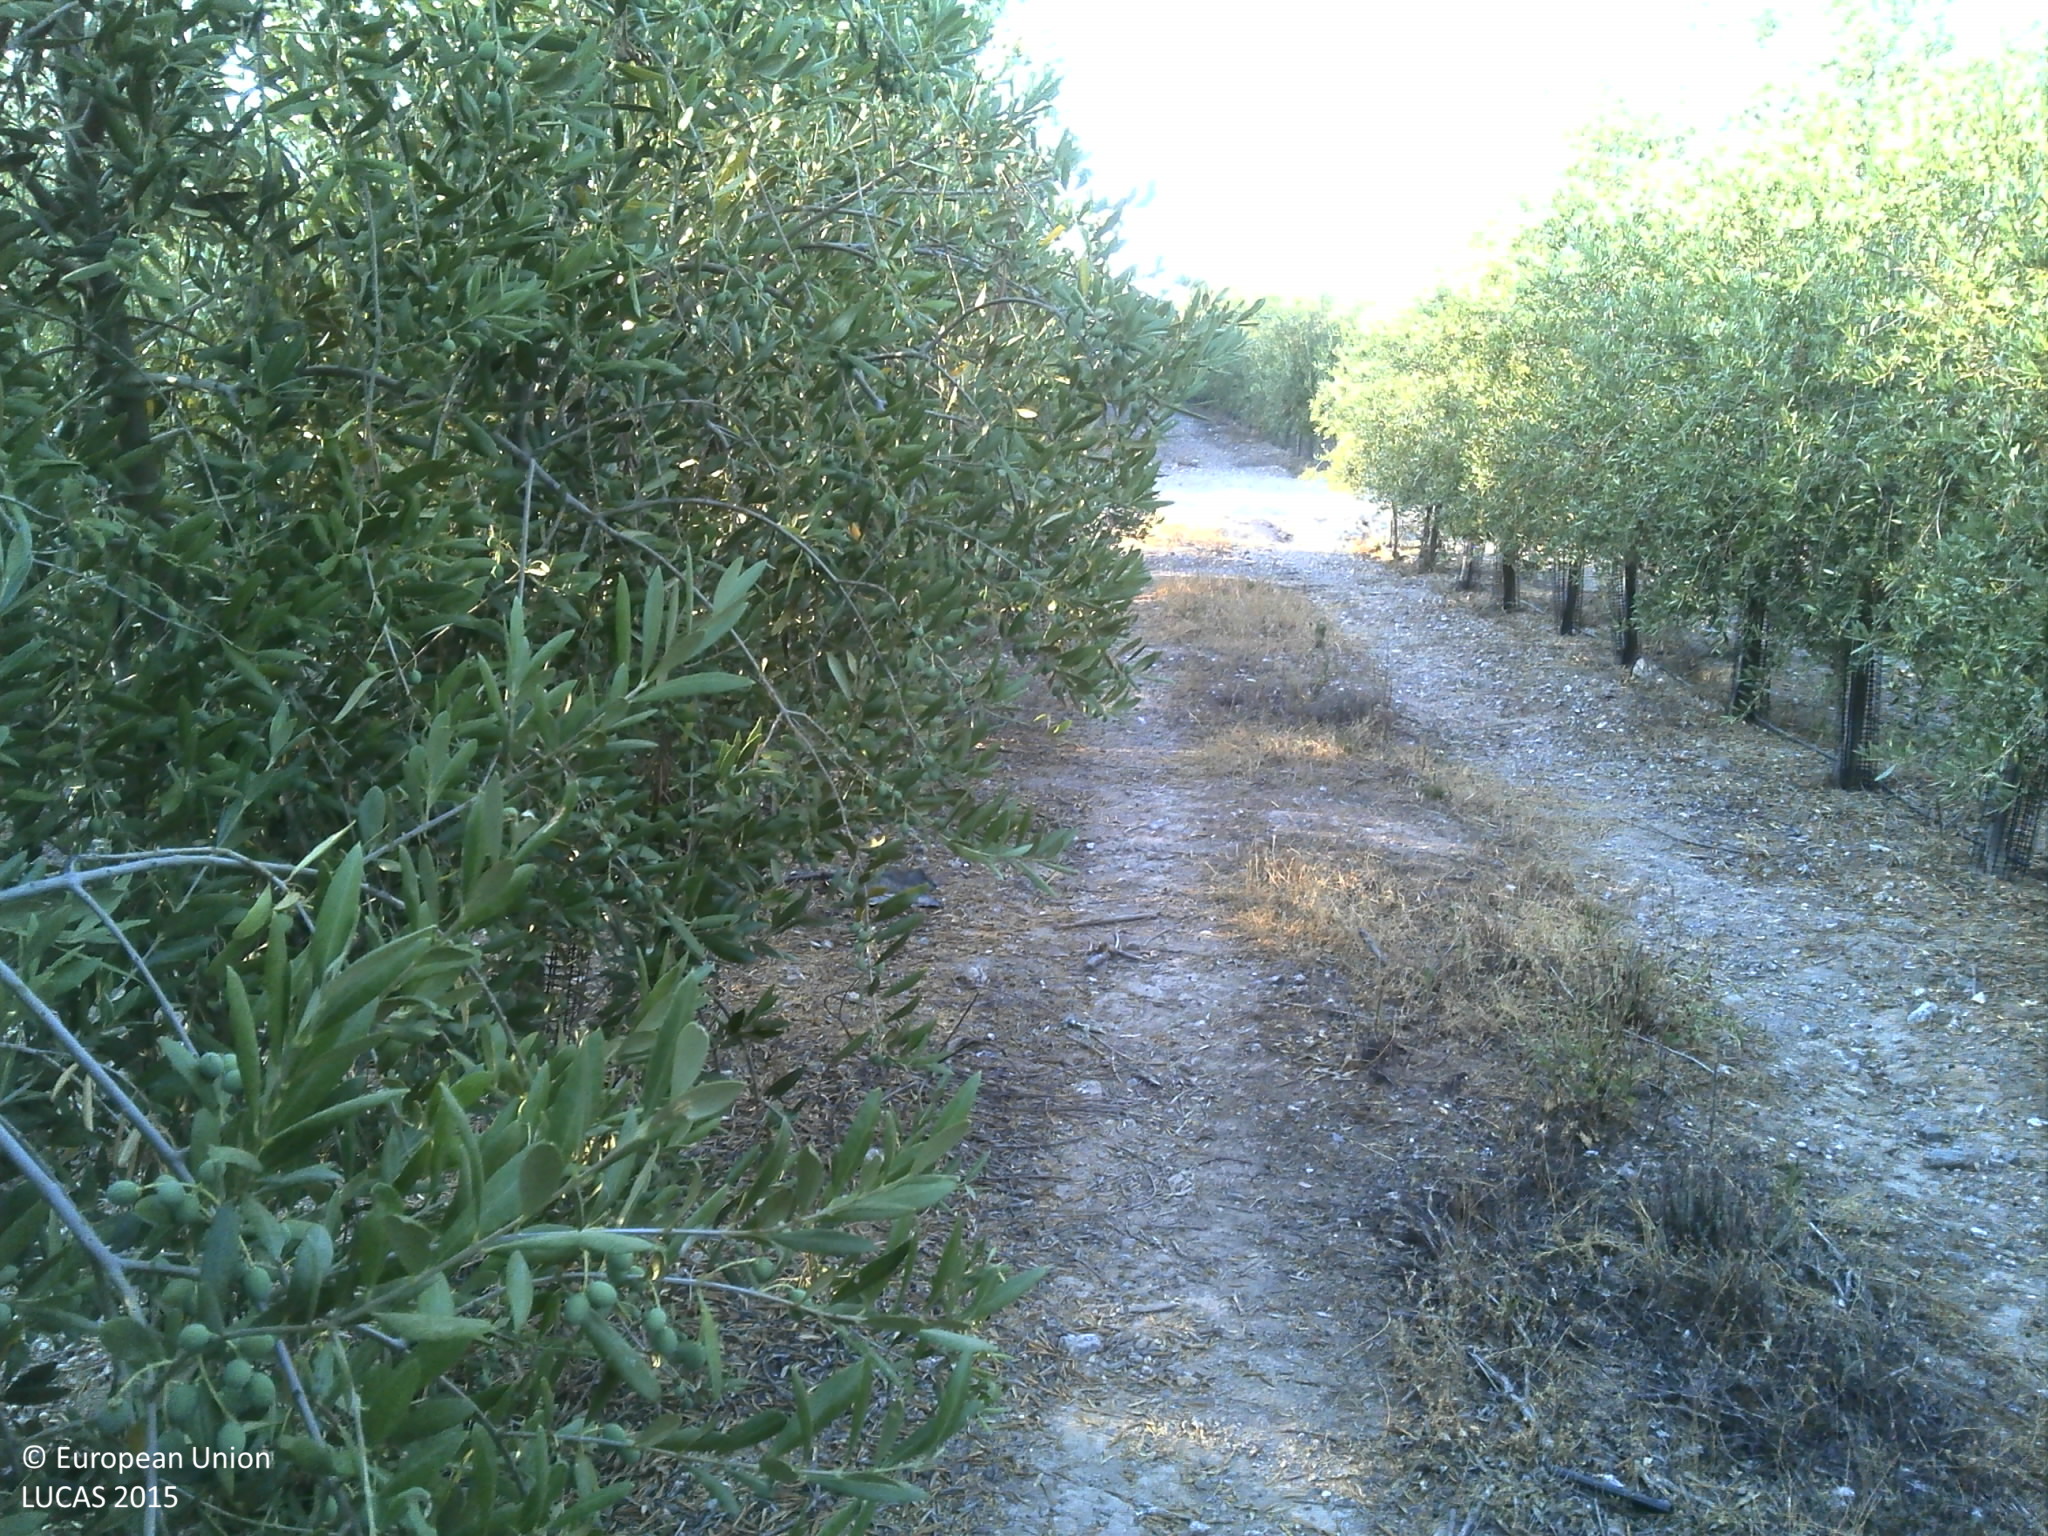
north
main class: Cropland
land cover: Olive groves
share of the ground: 50 - 75 %
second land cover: Grassland without tree/shrub cover
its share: 10 - 25 %
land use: Agriculture (excluding fallow land and kitchen gardens)
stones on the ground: < 10 %
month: June
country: PT
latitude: 38.3162
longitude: -7.3727
